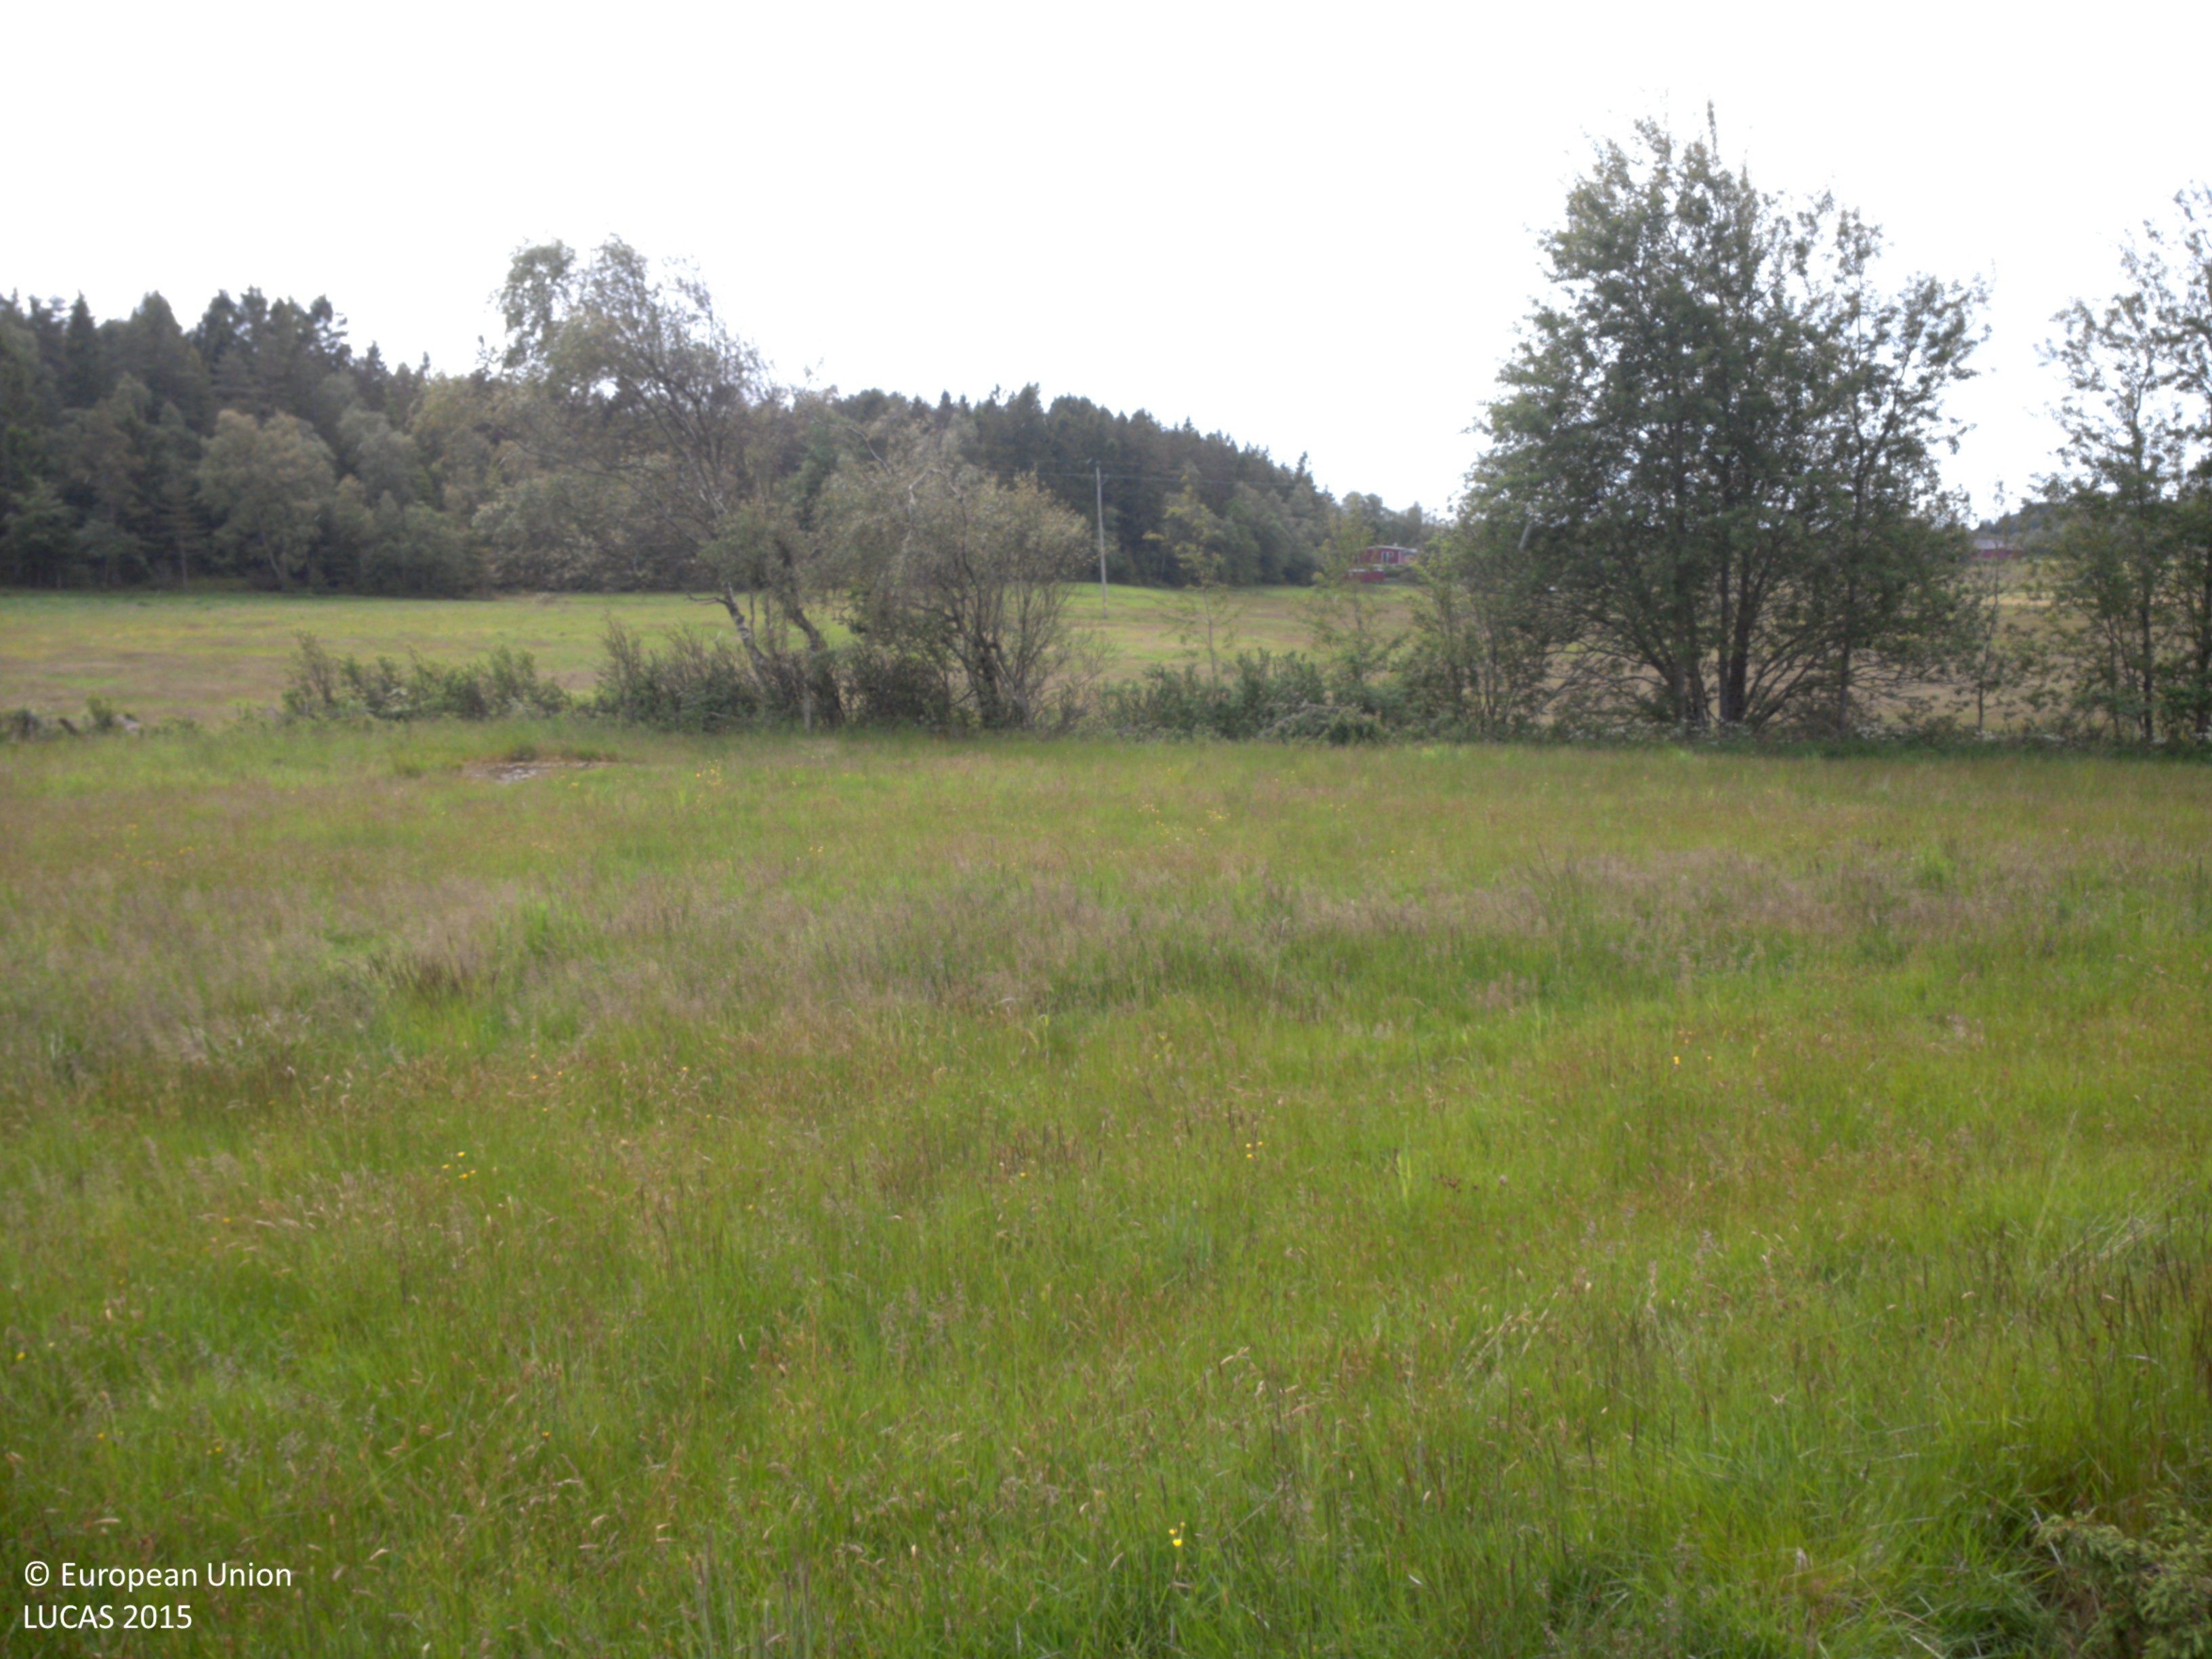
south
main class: Grassland
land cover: Grassland with sparse tree/shrub cover
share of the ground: > 75 %
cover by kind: herbaceous plants 95 %, coniferous forest trees 5 %
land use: Agriculture (excluding fallow land and kitchen gardens)
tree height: < 5 m
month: June
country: SE
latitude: 58.3728
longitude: 11.5185
